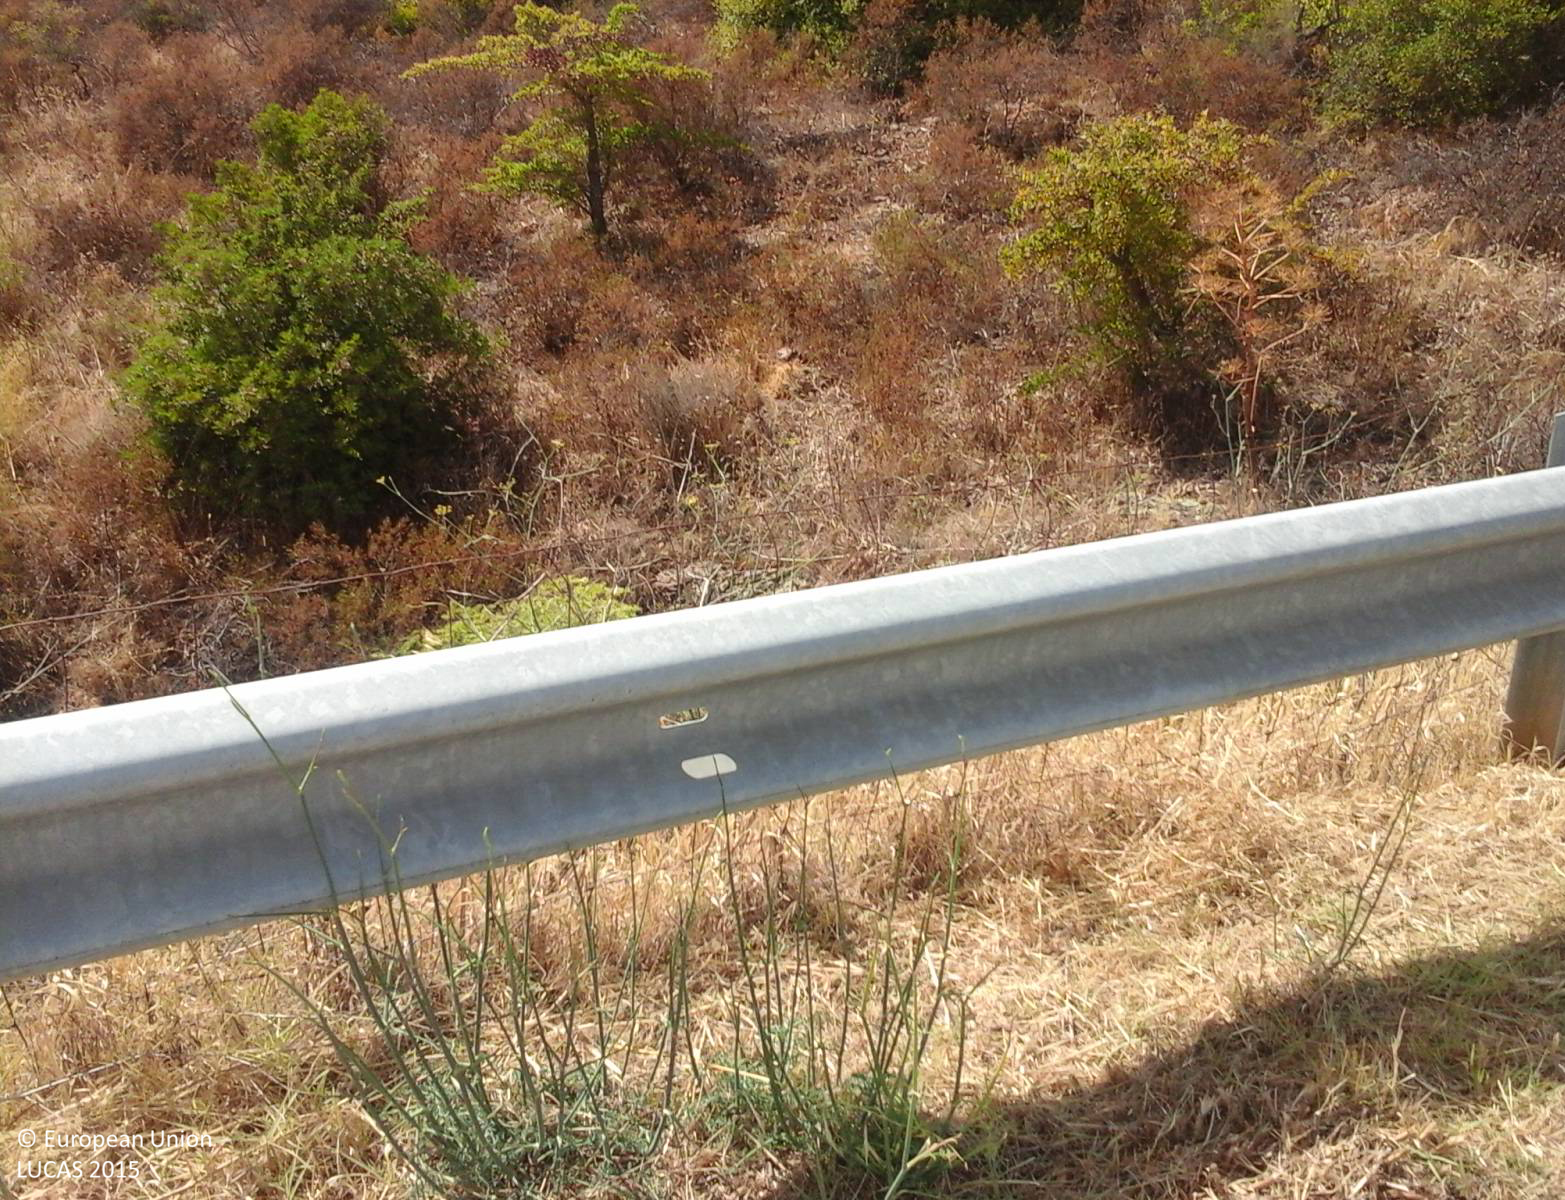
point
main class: Shrubland
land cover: Shrubland without tree cover
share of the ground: > 75 %
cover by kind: shrubs 100 %
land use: Agriculture (excluding fallow land and kitchen gardens)
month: August
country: IT
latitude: 39.3343
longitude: 8.6508
